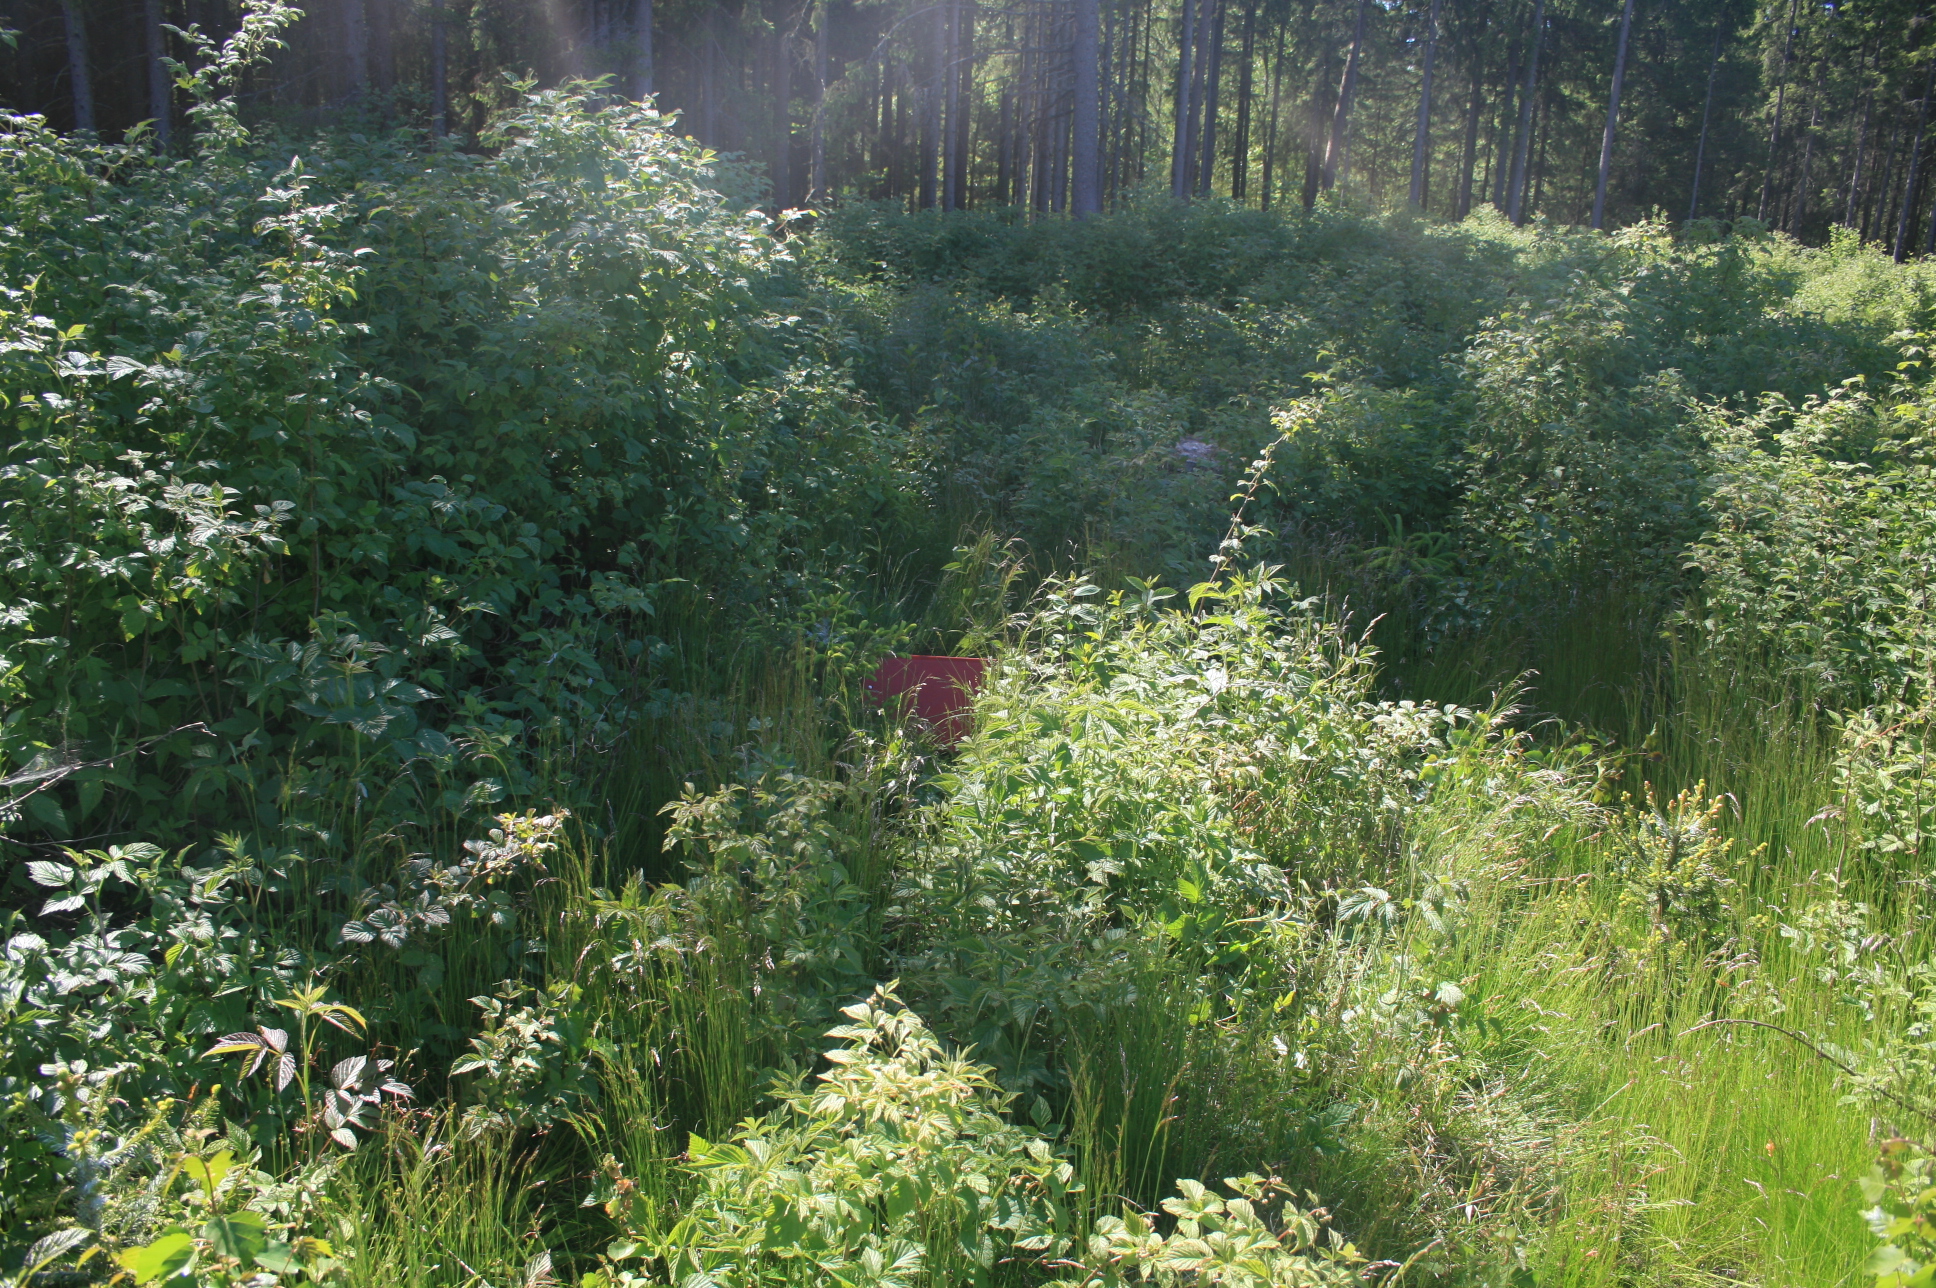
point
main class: Shrubland
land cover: Shrubland with sparse tree cover
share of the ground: > 75 %
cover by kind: shrubs 80 %, herbaceous plants 15 %, broadleaved forest trees 5 %
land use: Forestry
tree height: < 5 m
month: June
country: LT
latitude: 55.8152
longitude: 22.2644
